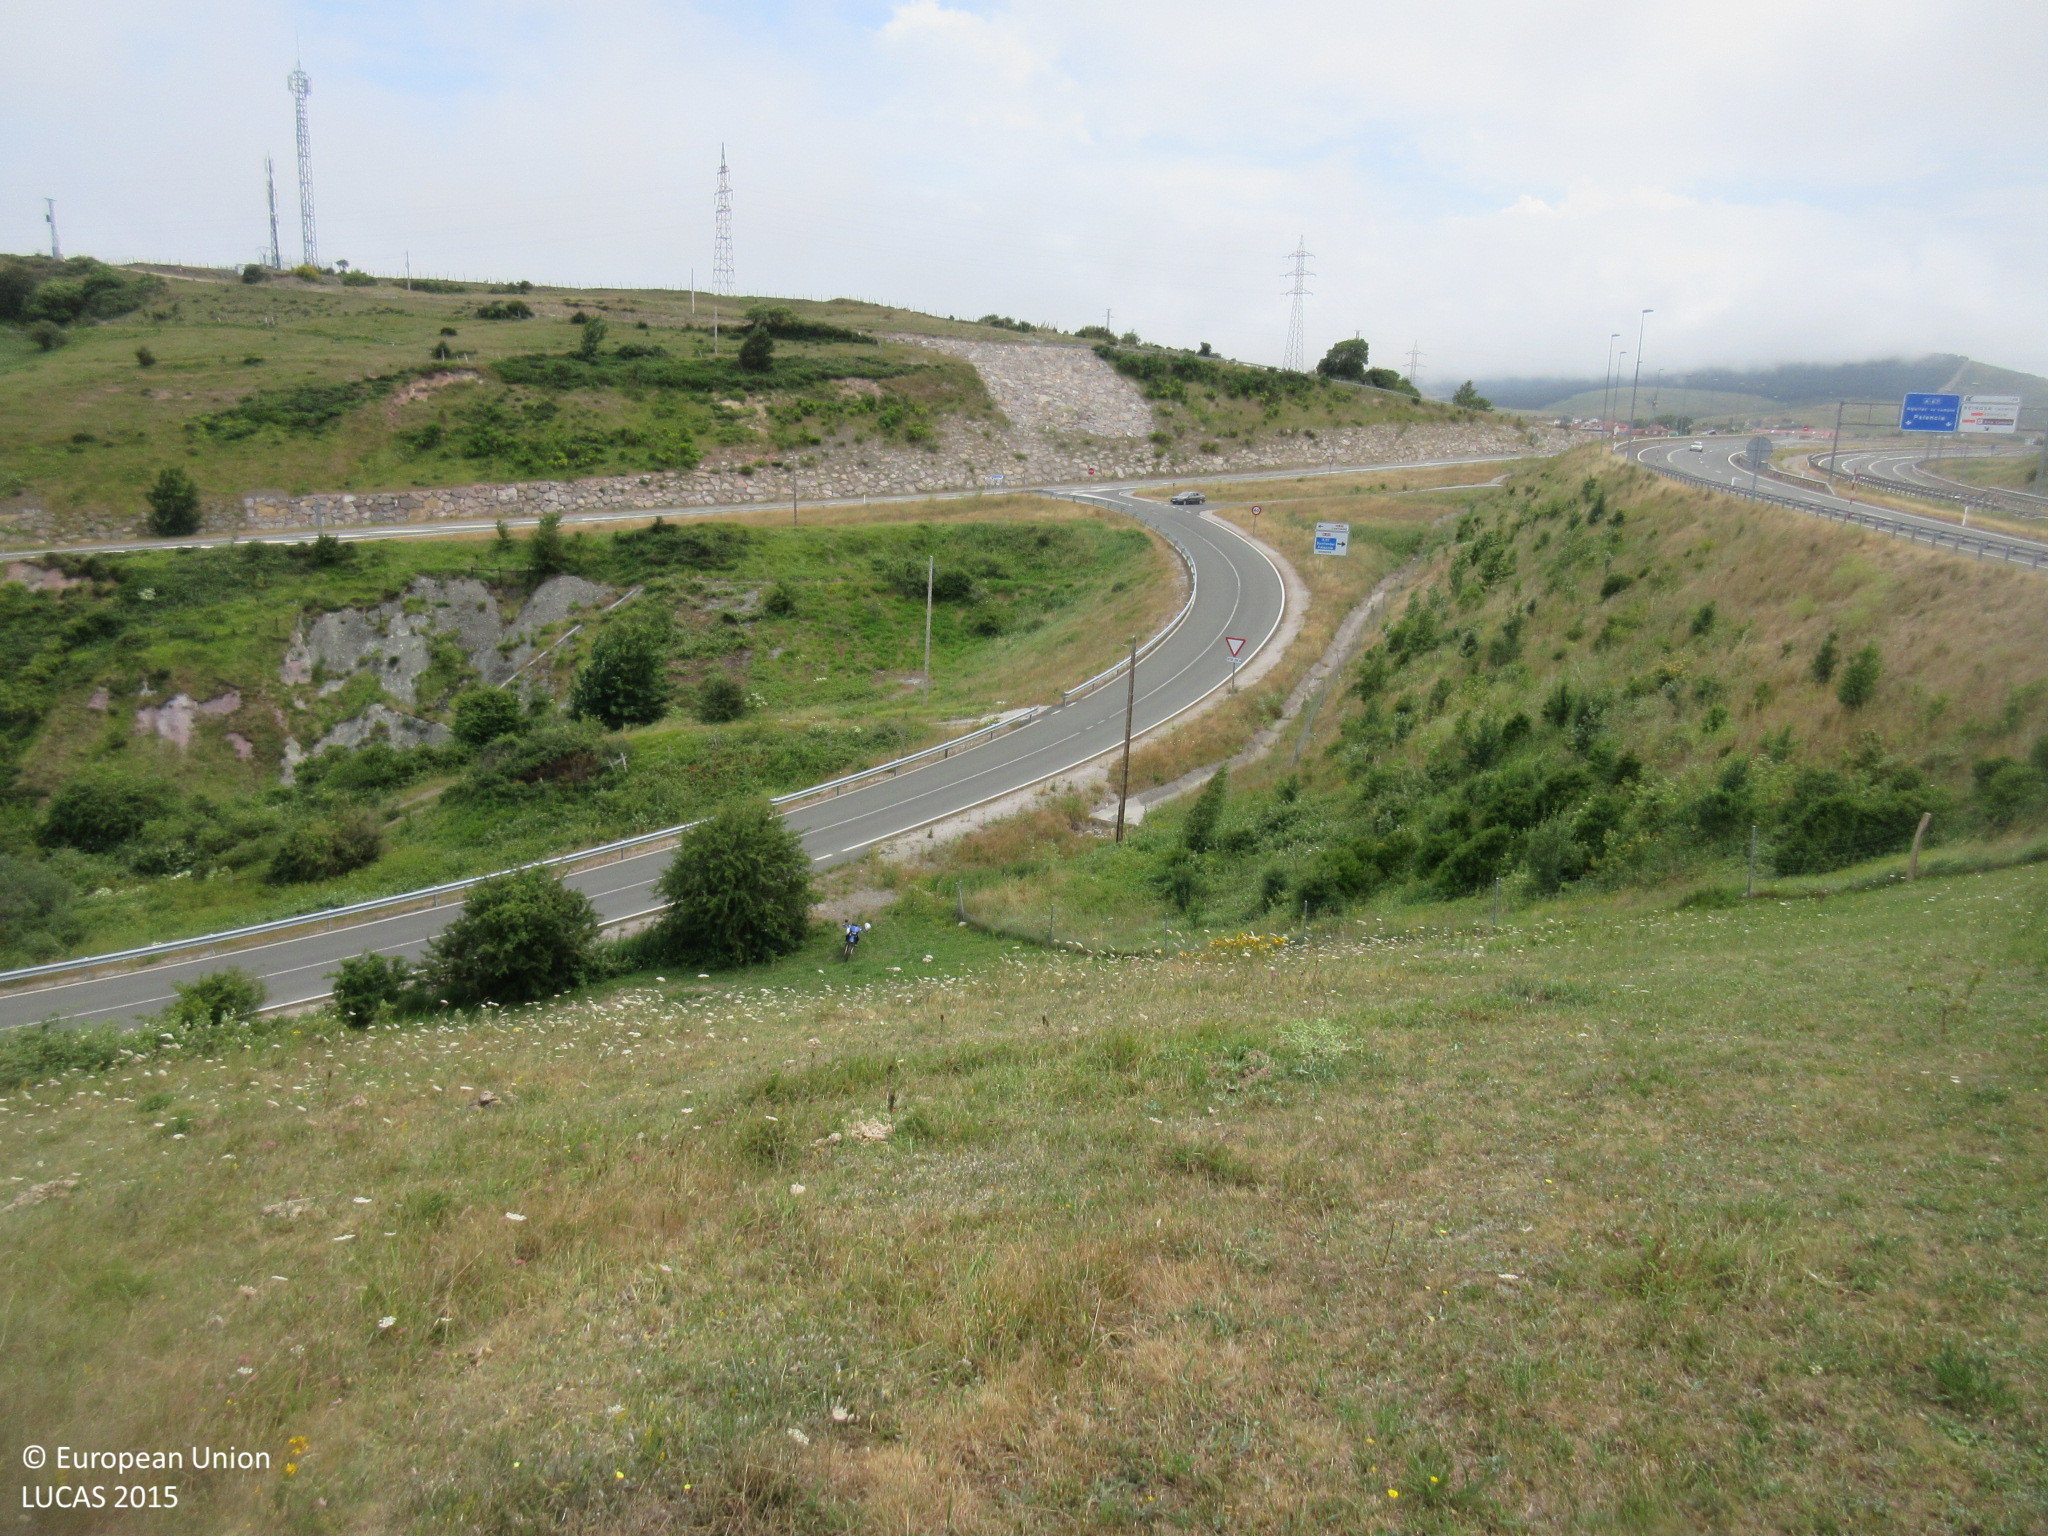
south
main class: Grassland
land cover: Grassland without tree/shrub cover
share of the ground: > 75 %
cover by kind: herbaceous plants 100 %
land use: Agriculture (excluding fallow land and kitchen gardens)
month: July
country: ES
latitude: 43.0131
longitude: -4.1230
